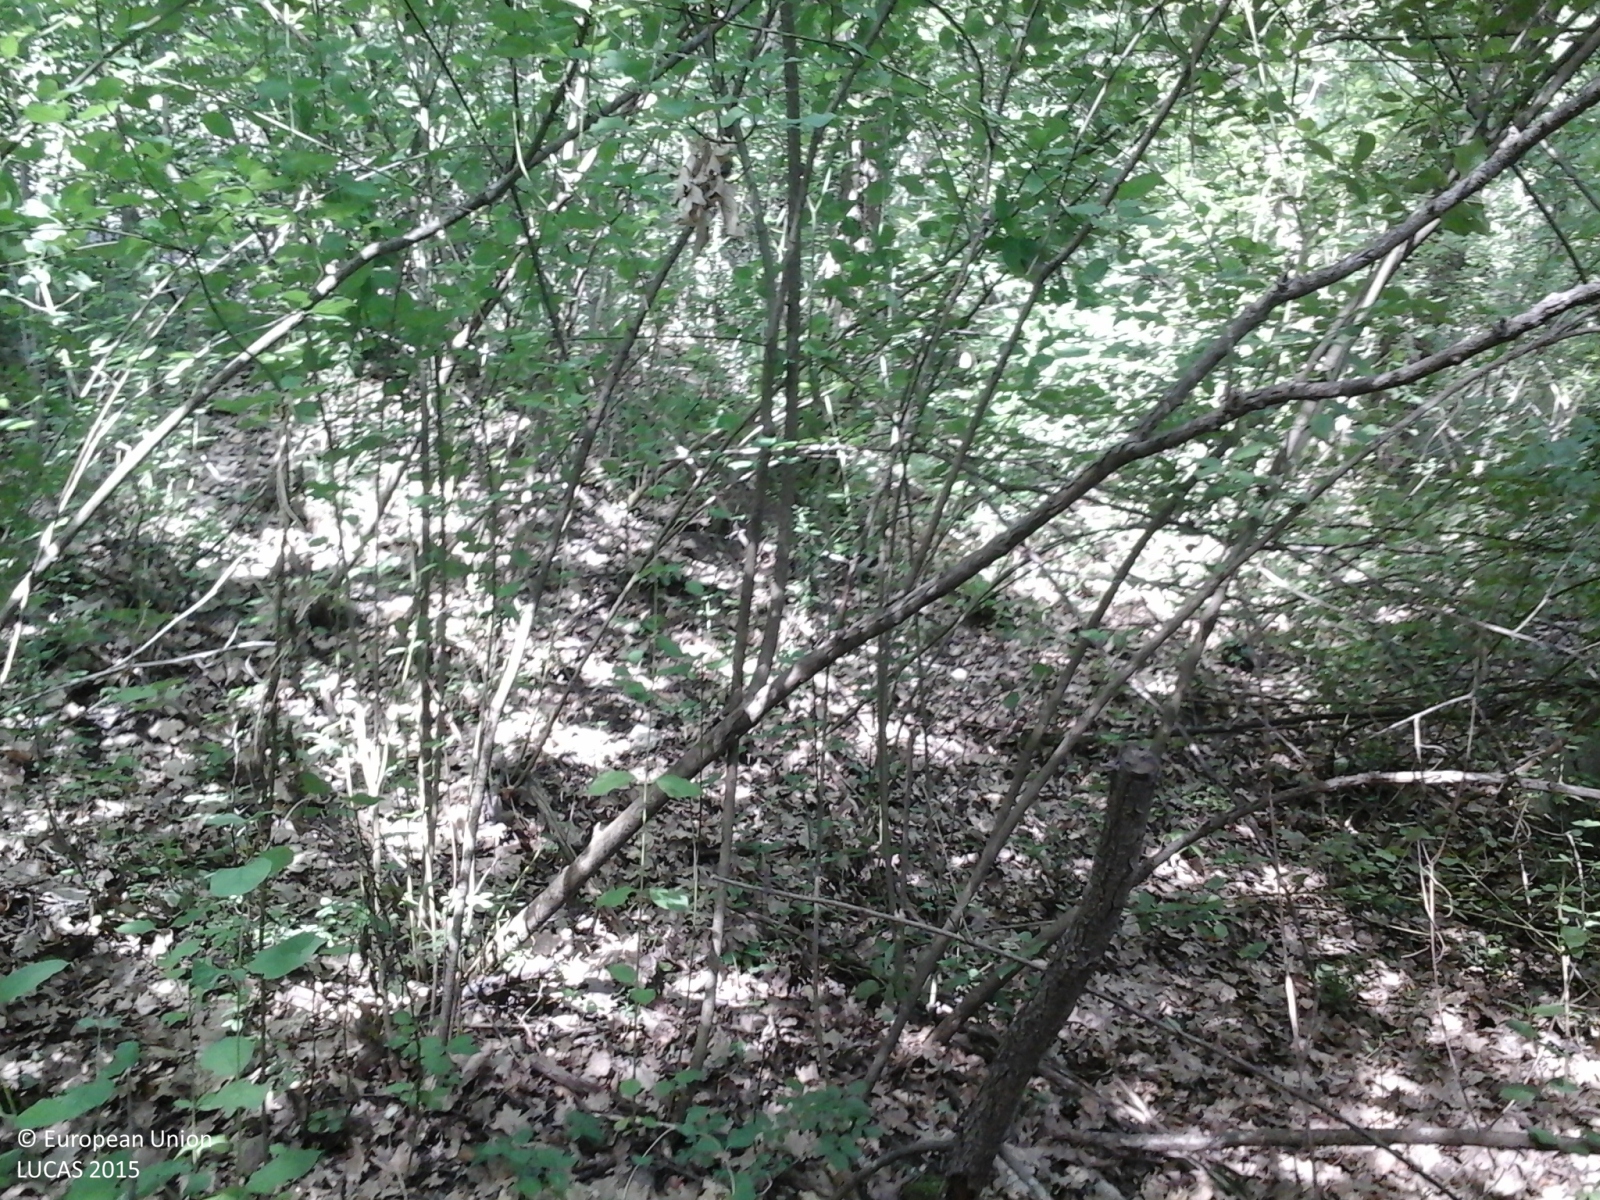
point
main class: Woodland
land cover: Broadleaved woodland
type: thermophilous deciduous forest
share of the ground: > 75 %
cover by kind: broadleaved forest trees 90 %, shrubs 10 %
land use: Forestry
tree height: > 5 m
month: June
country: IT
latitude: 44.2655
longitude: 11.6373
